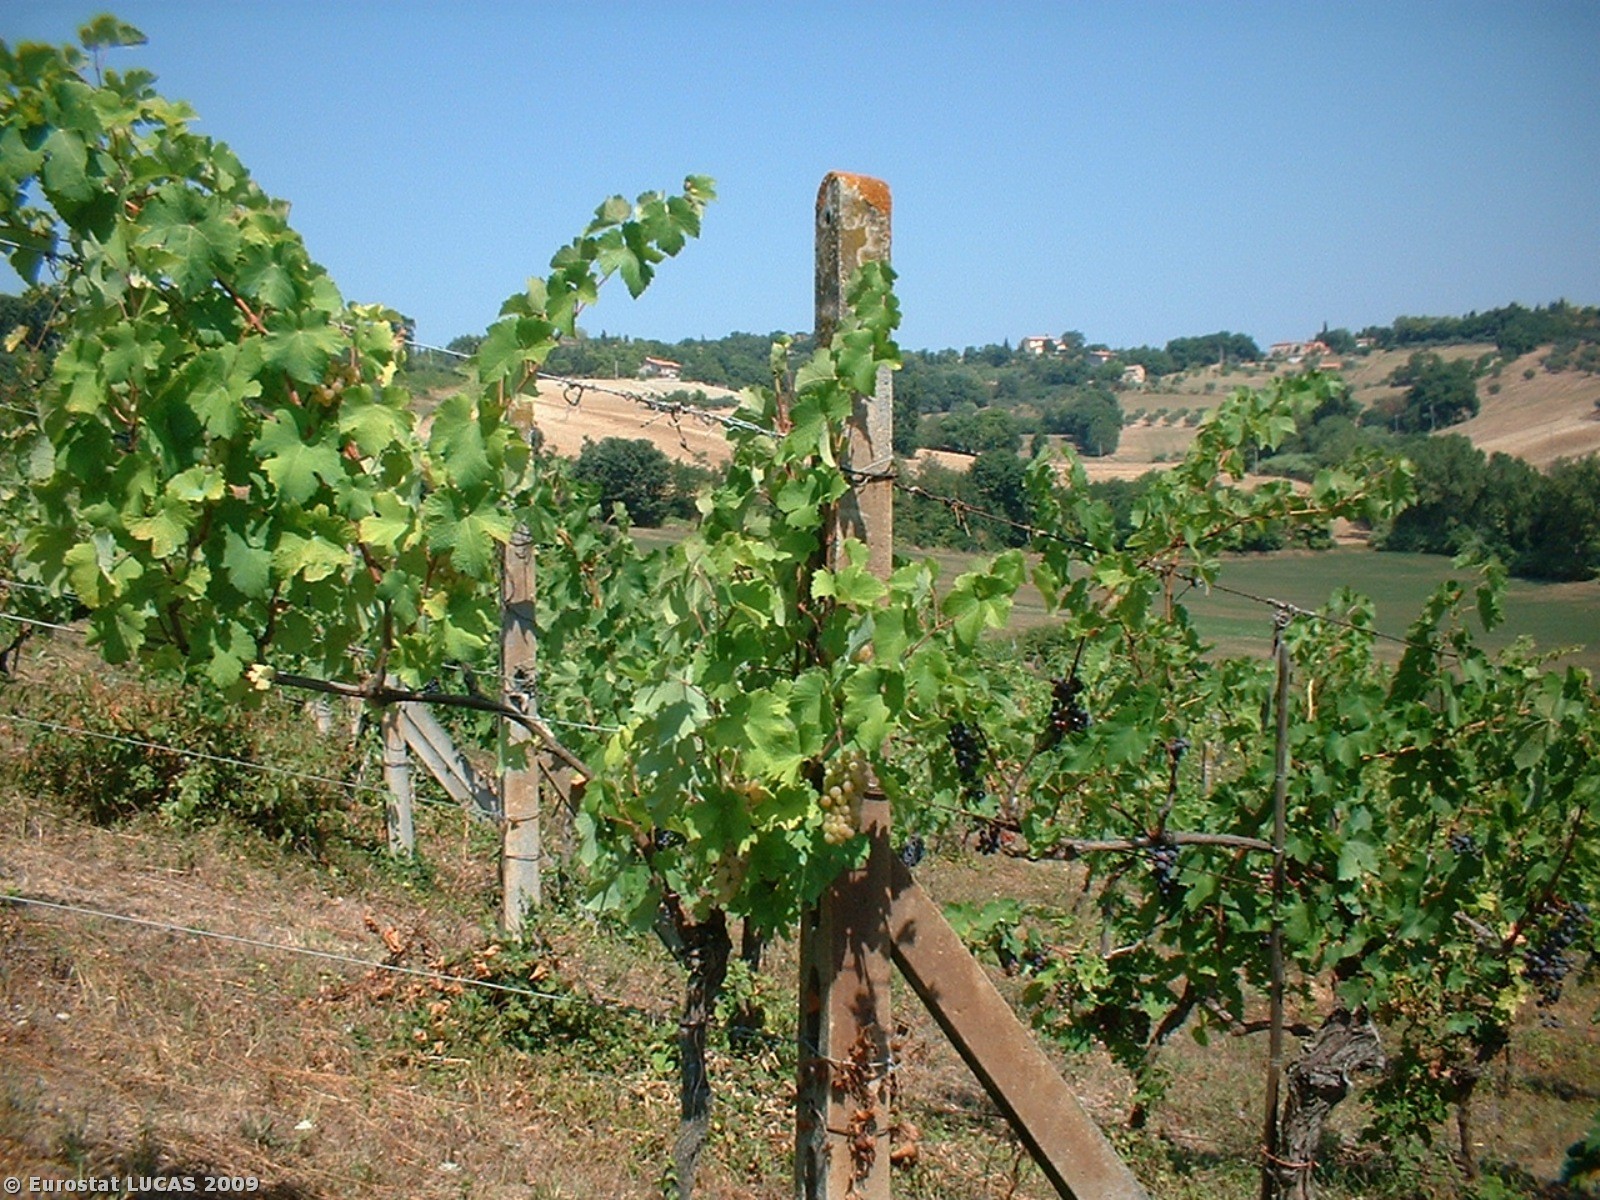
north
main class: Cropland
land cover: Vineyards
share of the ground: 25 - 50 %
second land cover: Grassland with sparse tree/shrub cover
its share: > 75 %
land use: Agriculture (excluding fallow land and kitchen gardens)
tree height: < 5 m
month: July
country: IT
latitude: 43.8396
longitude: 12.9408
